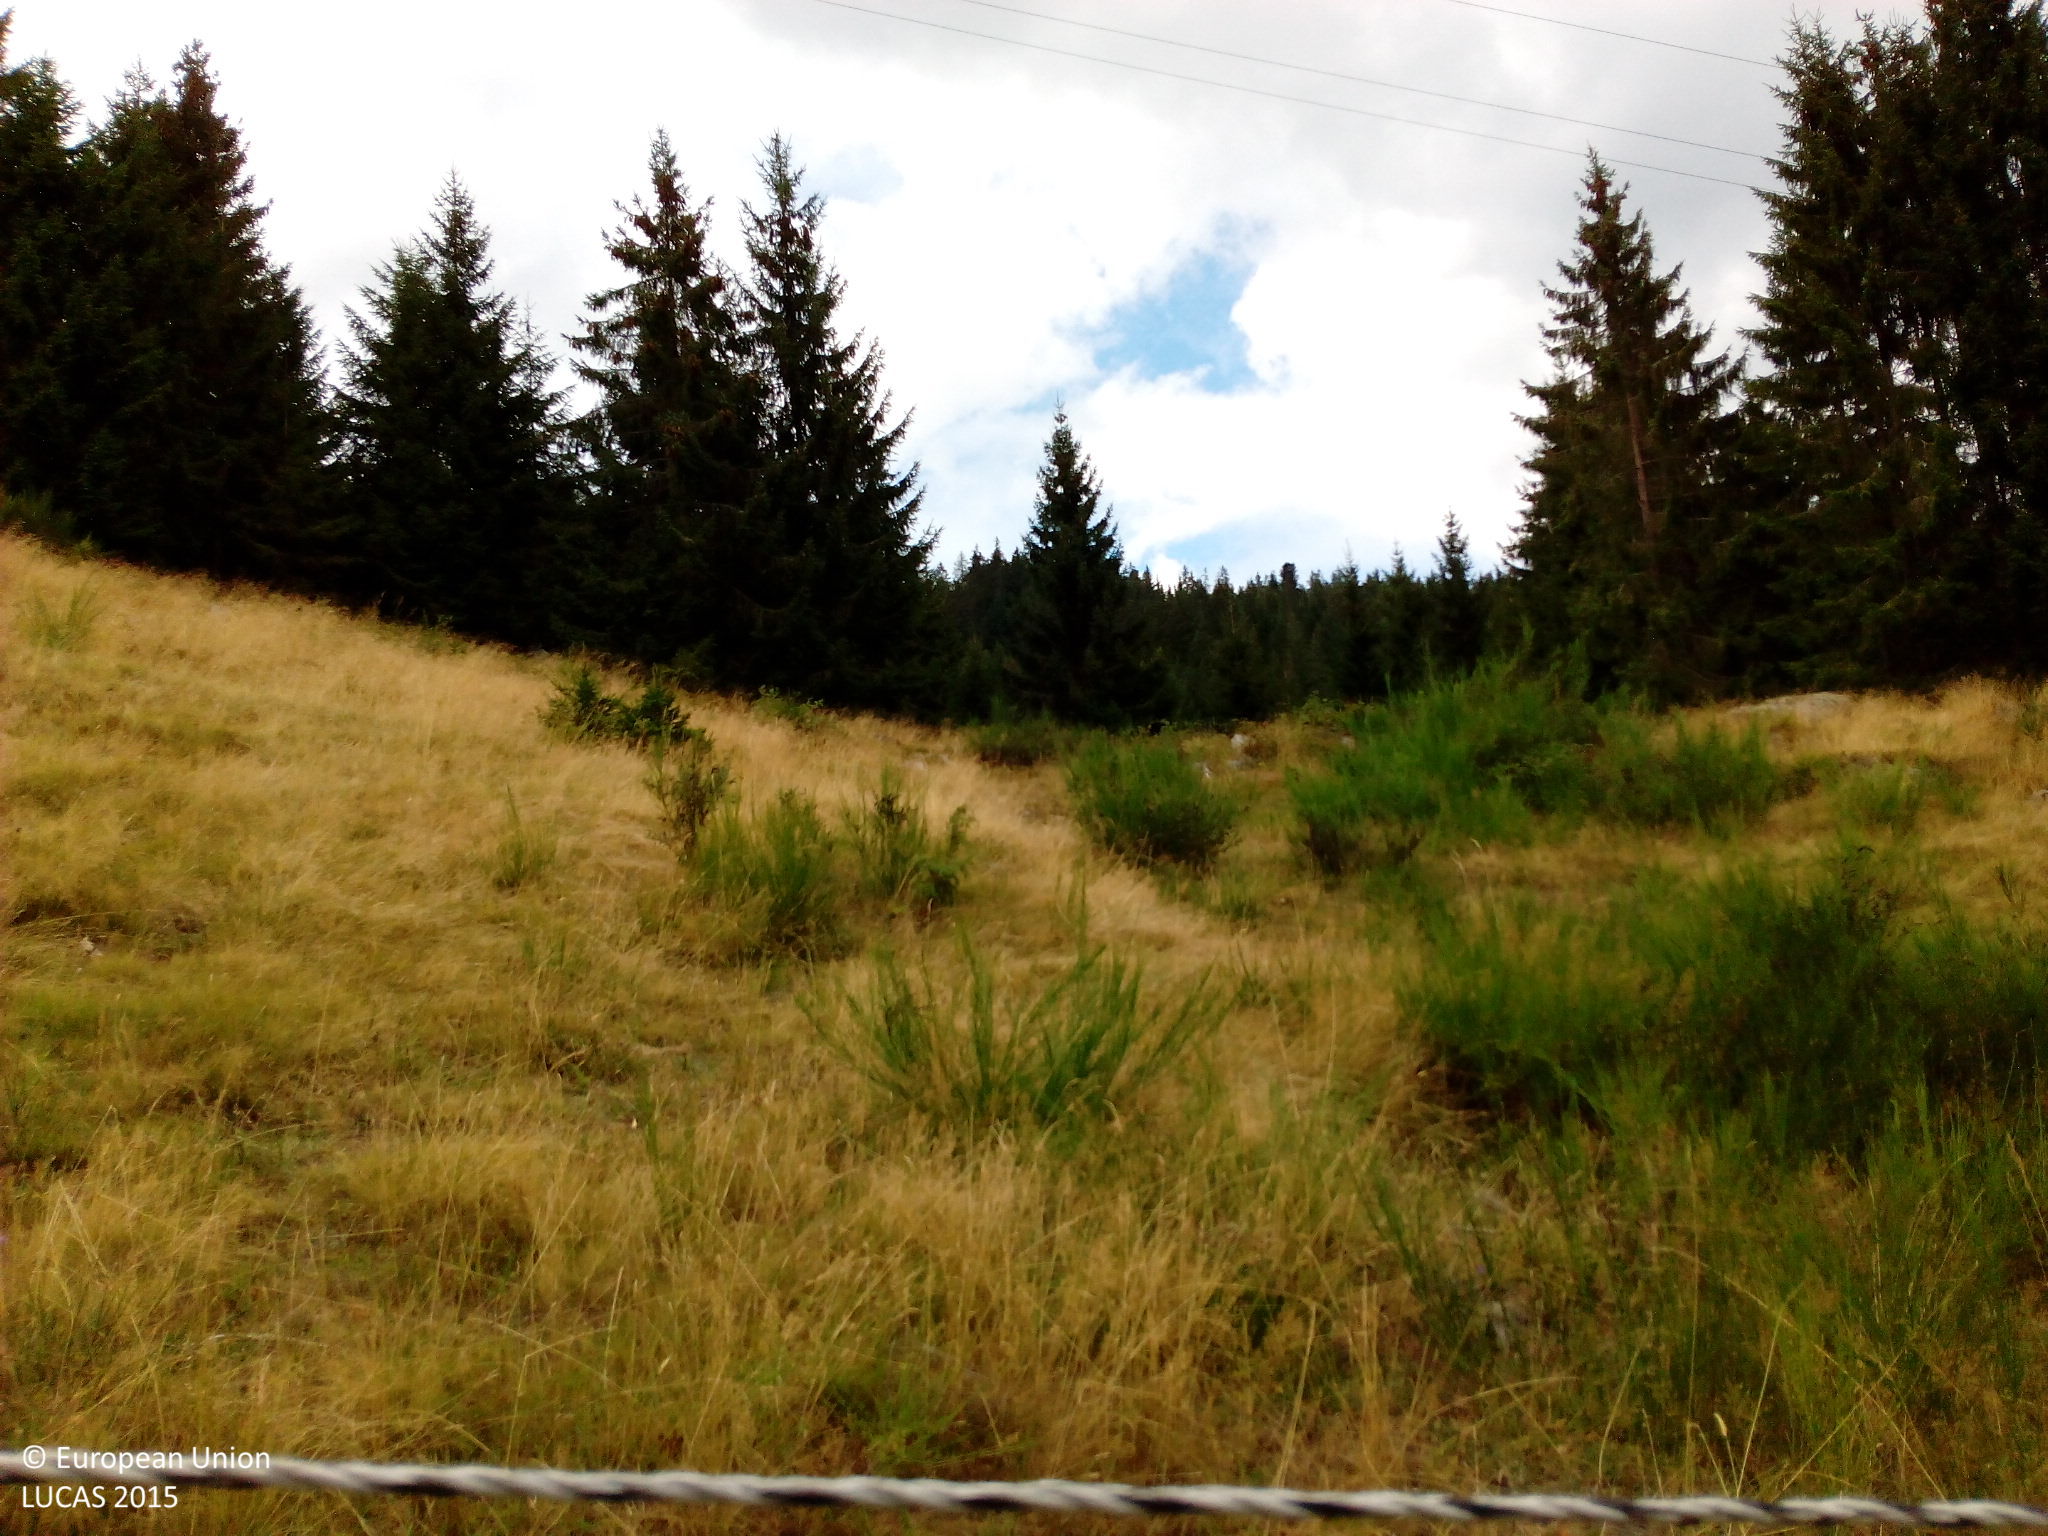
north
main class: Shrubland
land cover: Shrubland without tree cover
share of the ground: 25 - 50 %
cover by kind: herbaceous plants 75 %, shrubs 25 %
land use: Agriculture (excluding fallow land and kitchen gardens)
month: August
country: DE
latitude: 47.7939
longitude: 8.1456
